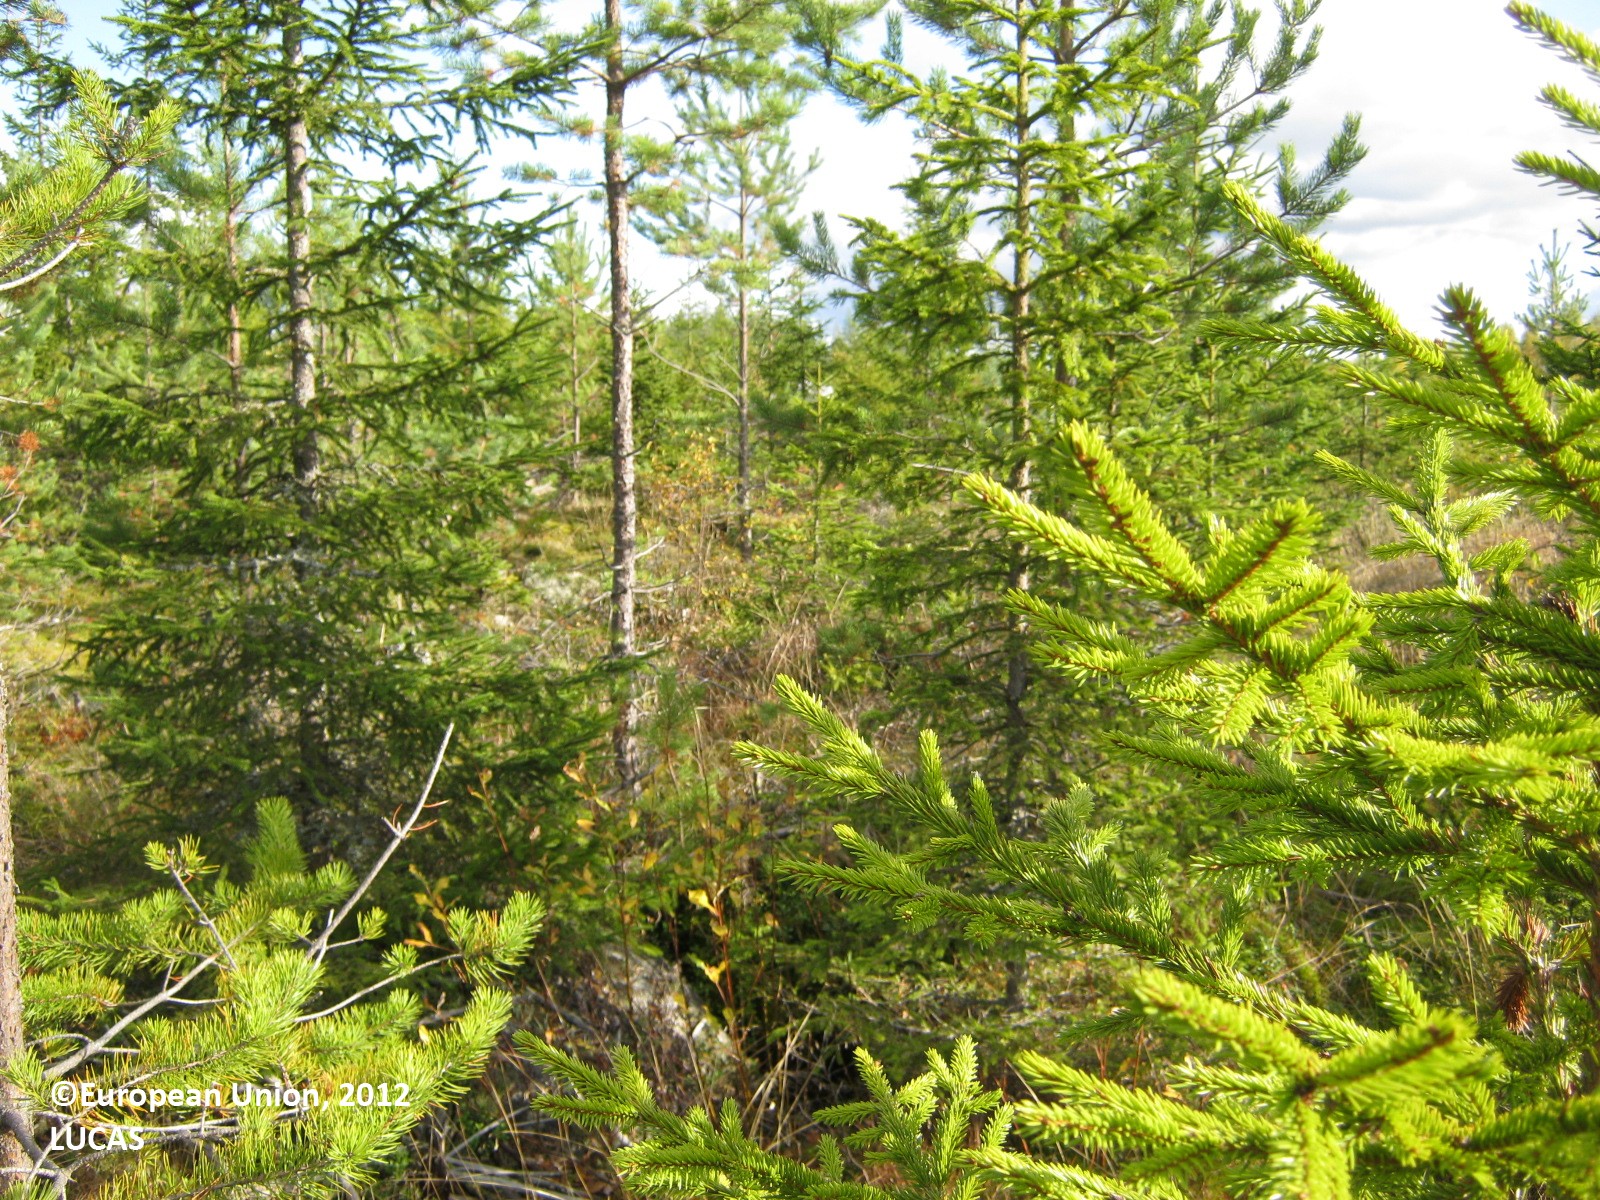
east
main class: Woodland
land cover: Other mixed woodland
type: boreal forest
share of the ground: 50 - 75 %
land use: Forestry
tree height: < 5 m
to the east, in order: Other mixed woodland; Spruce dominated coniferous woodland
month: September
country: FI
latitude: 62.2919
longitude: 28.8991
